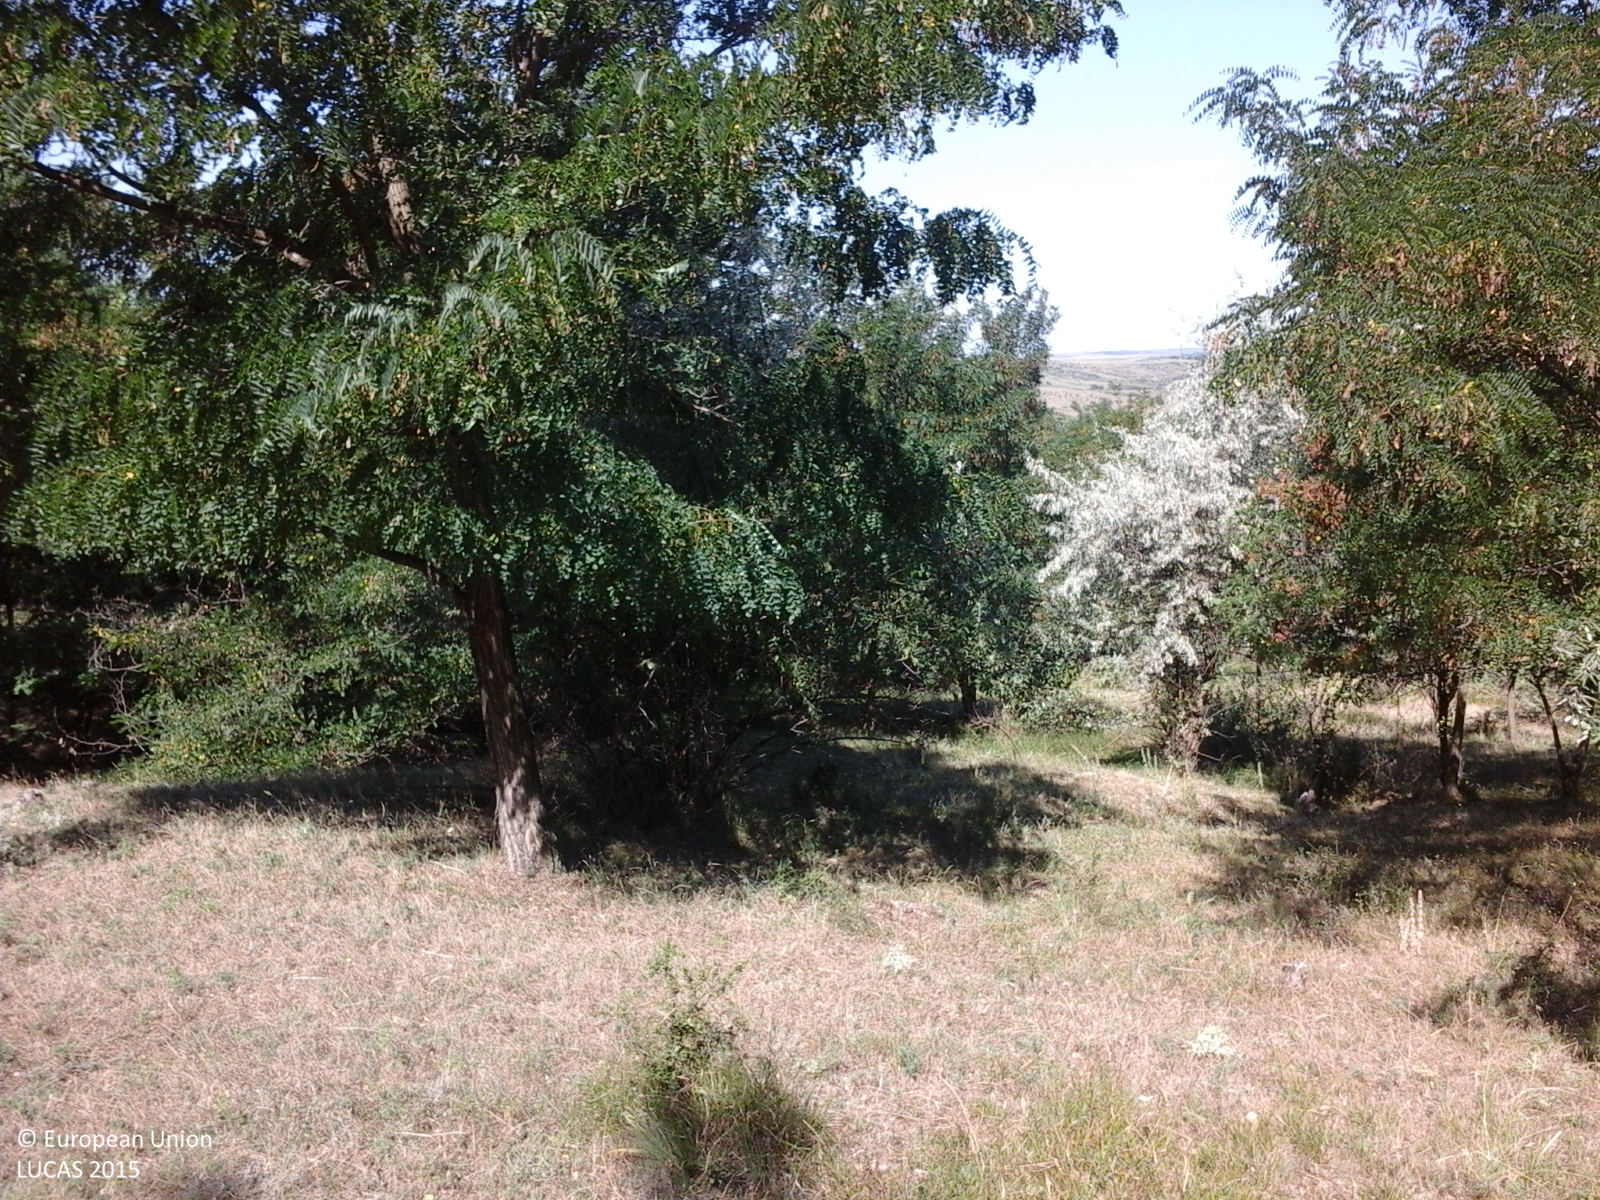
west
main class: Woodland
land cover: Broadleaved woodland
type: exotic forest
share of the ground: > 75 %
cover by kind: broadleaved forest trees 100 %
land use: Forestry
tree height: > 5 m
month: July
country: RO
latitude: 46.0305
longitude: 27.7497
